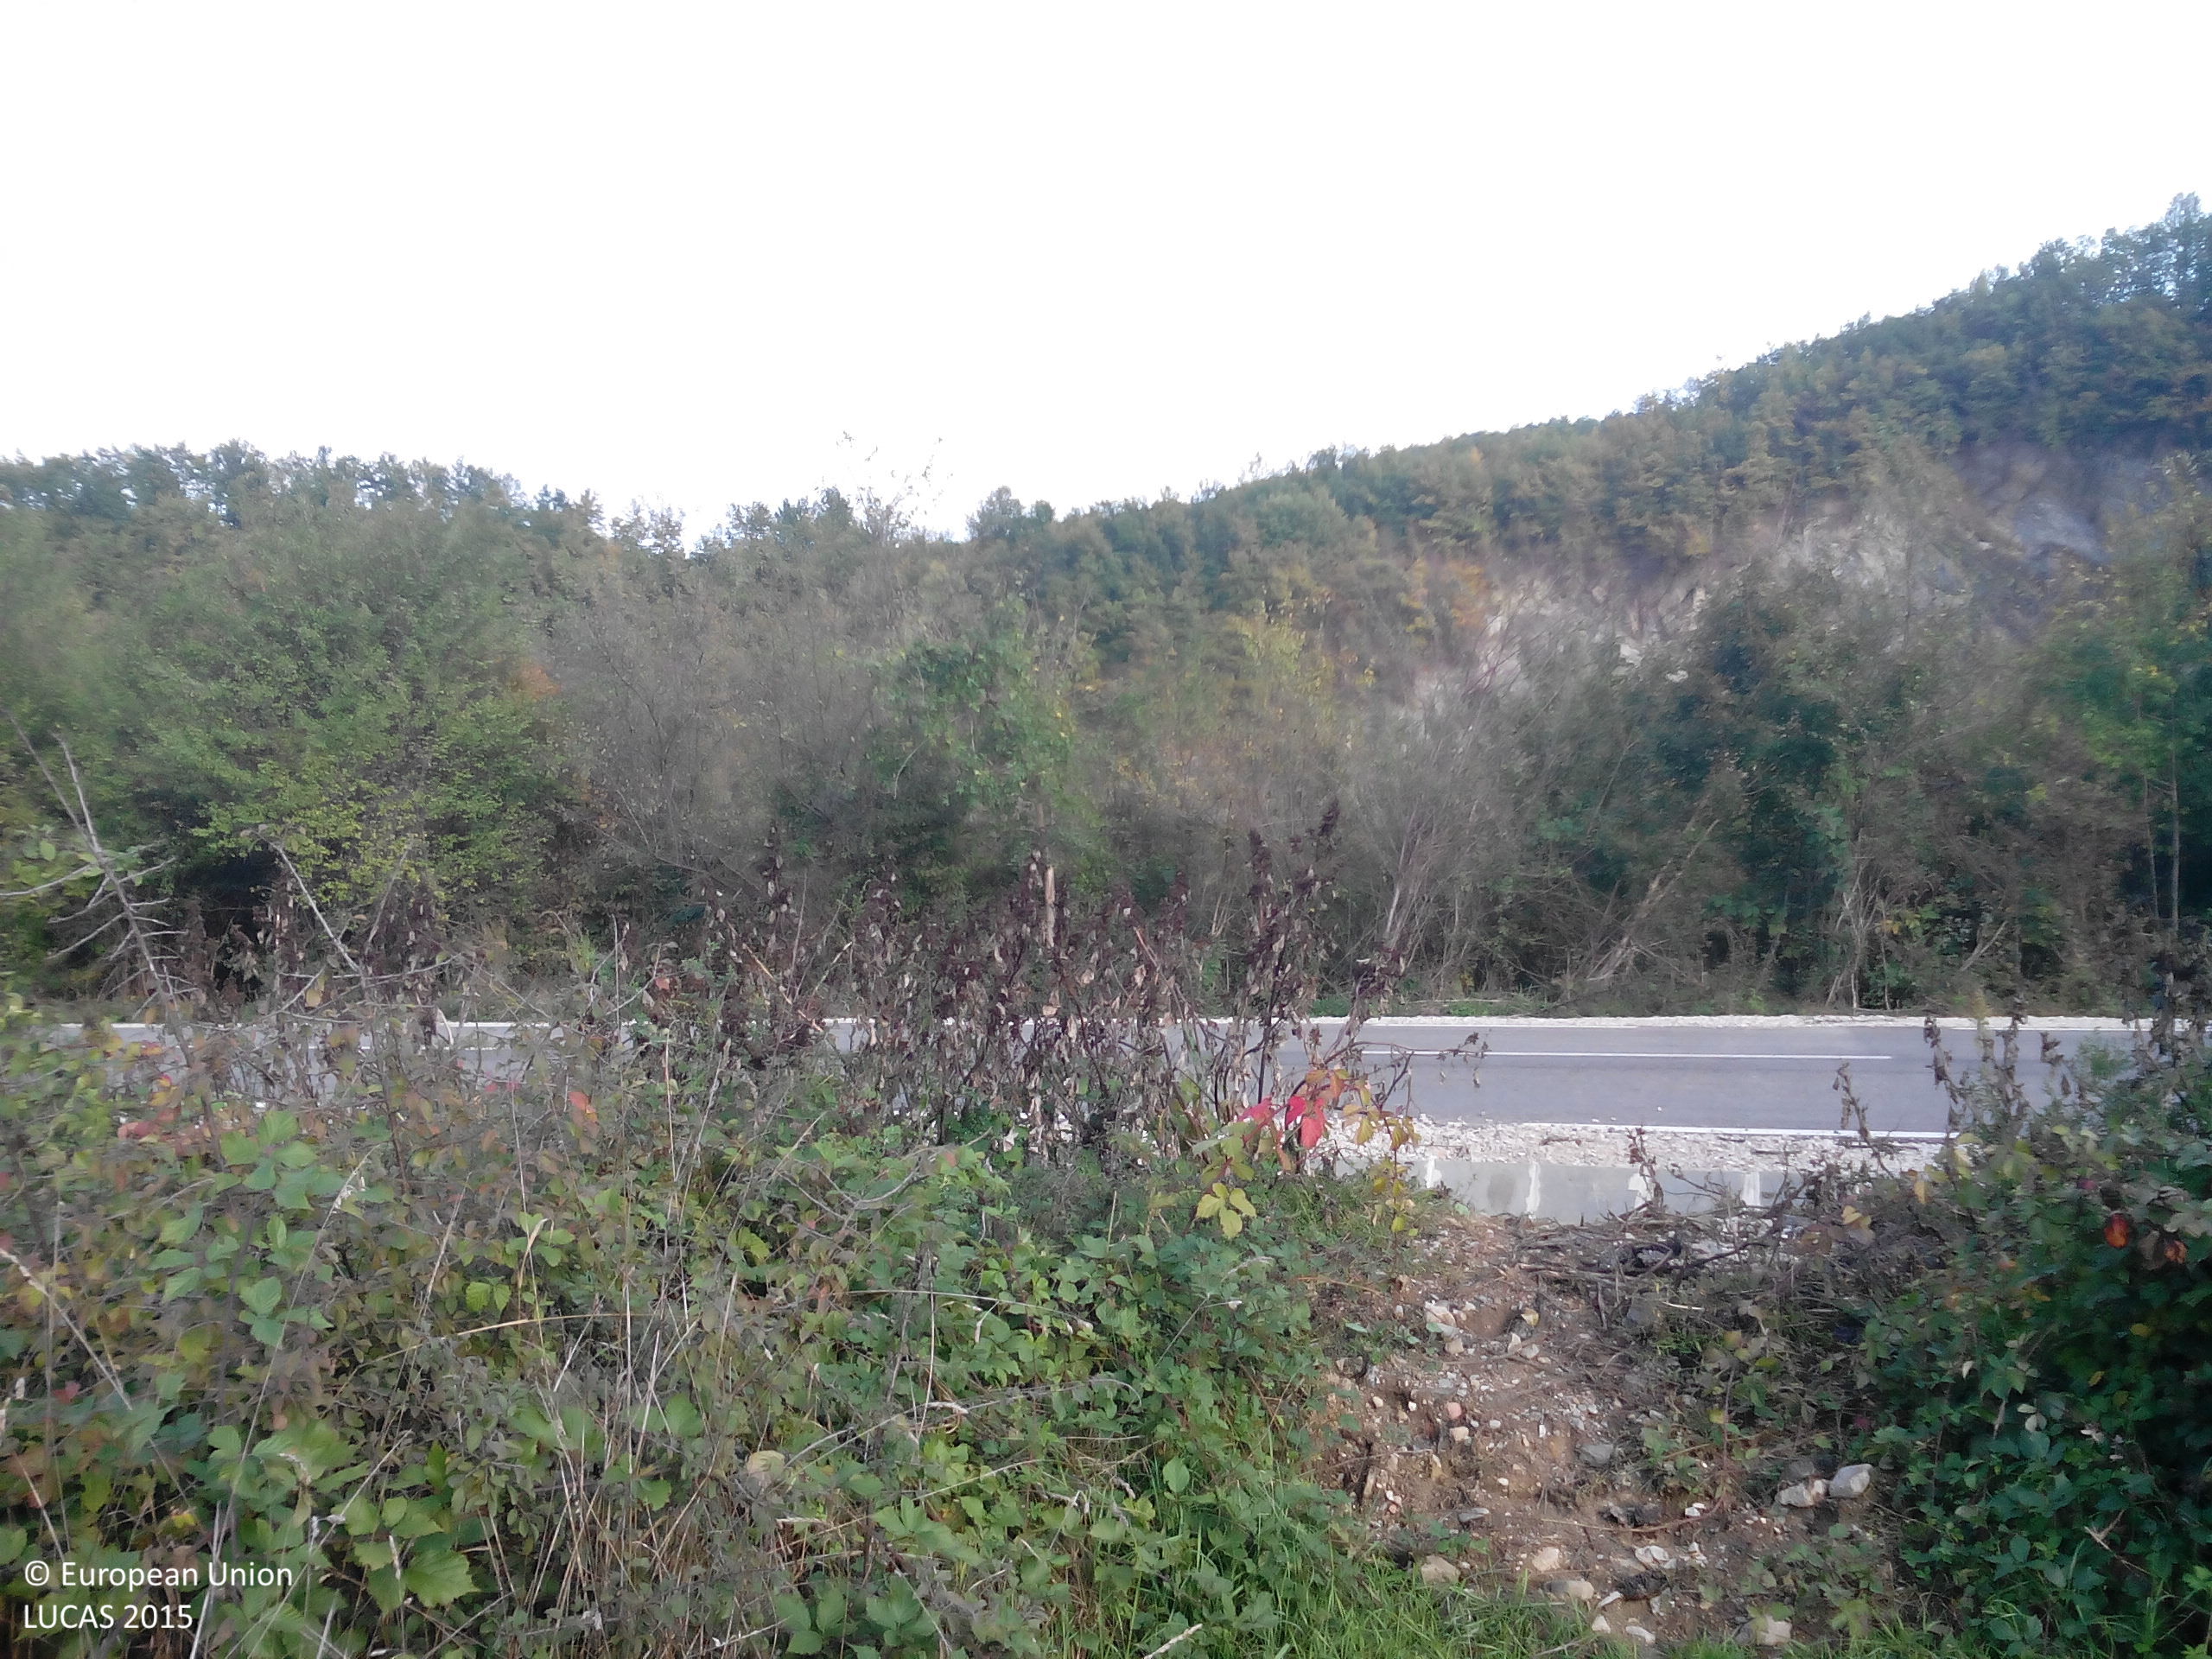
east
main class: Grassland
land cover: Grassland without tree/shrub cover
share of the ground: > 75 %
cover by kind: herbaceous plants 95 %, shrubs 5 %
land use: Agriculture (excluding fallow land and kitchen gardens)
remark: Harvested field
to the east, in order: Grassland without tree/shrub cover; Shrubland without tree cover; Ditches and canals; Paved roads, cycling and walking lanes; Ditches and canals; Shrubland with sparse tree cover; Grassland without tree/shrub cover; Shrubland with sparse tree cover; Inland fresh running water; Grassland with sparse tree/shrub cover; Rocks and stones
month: October
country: BG
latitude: 42.9103
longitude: 24.0731
